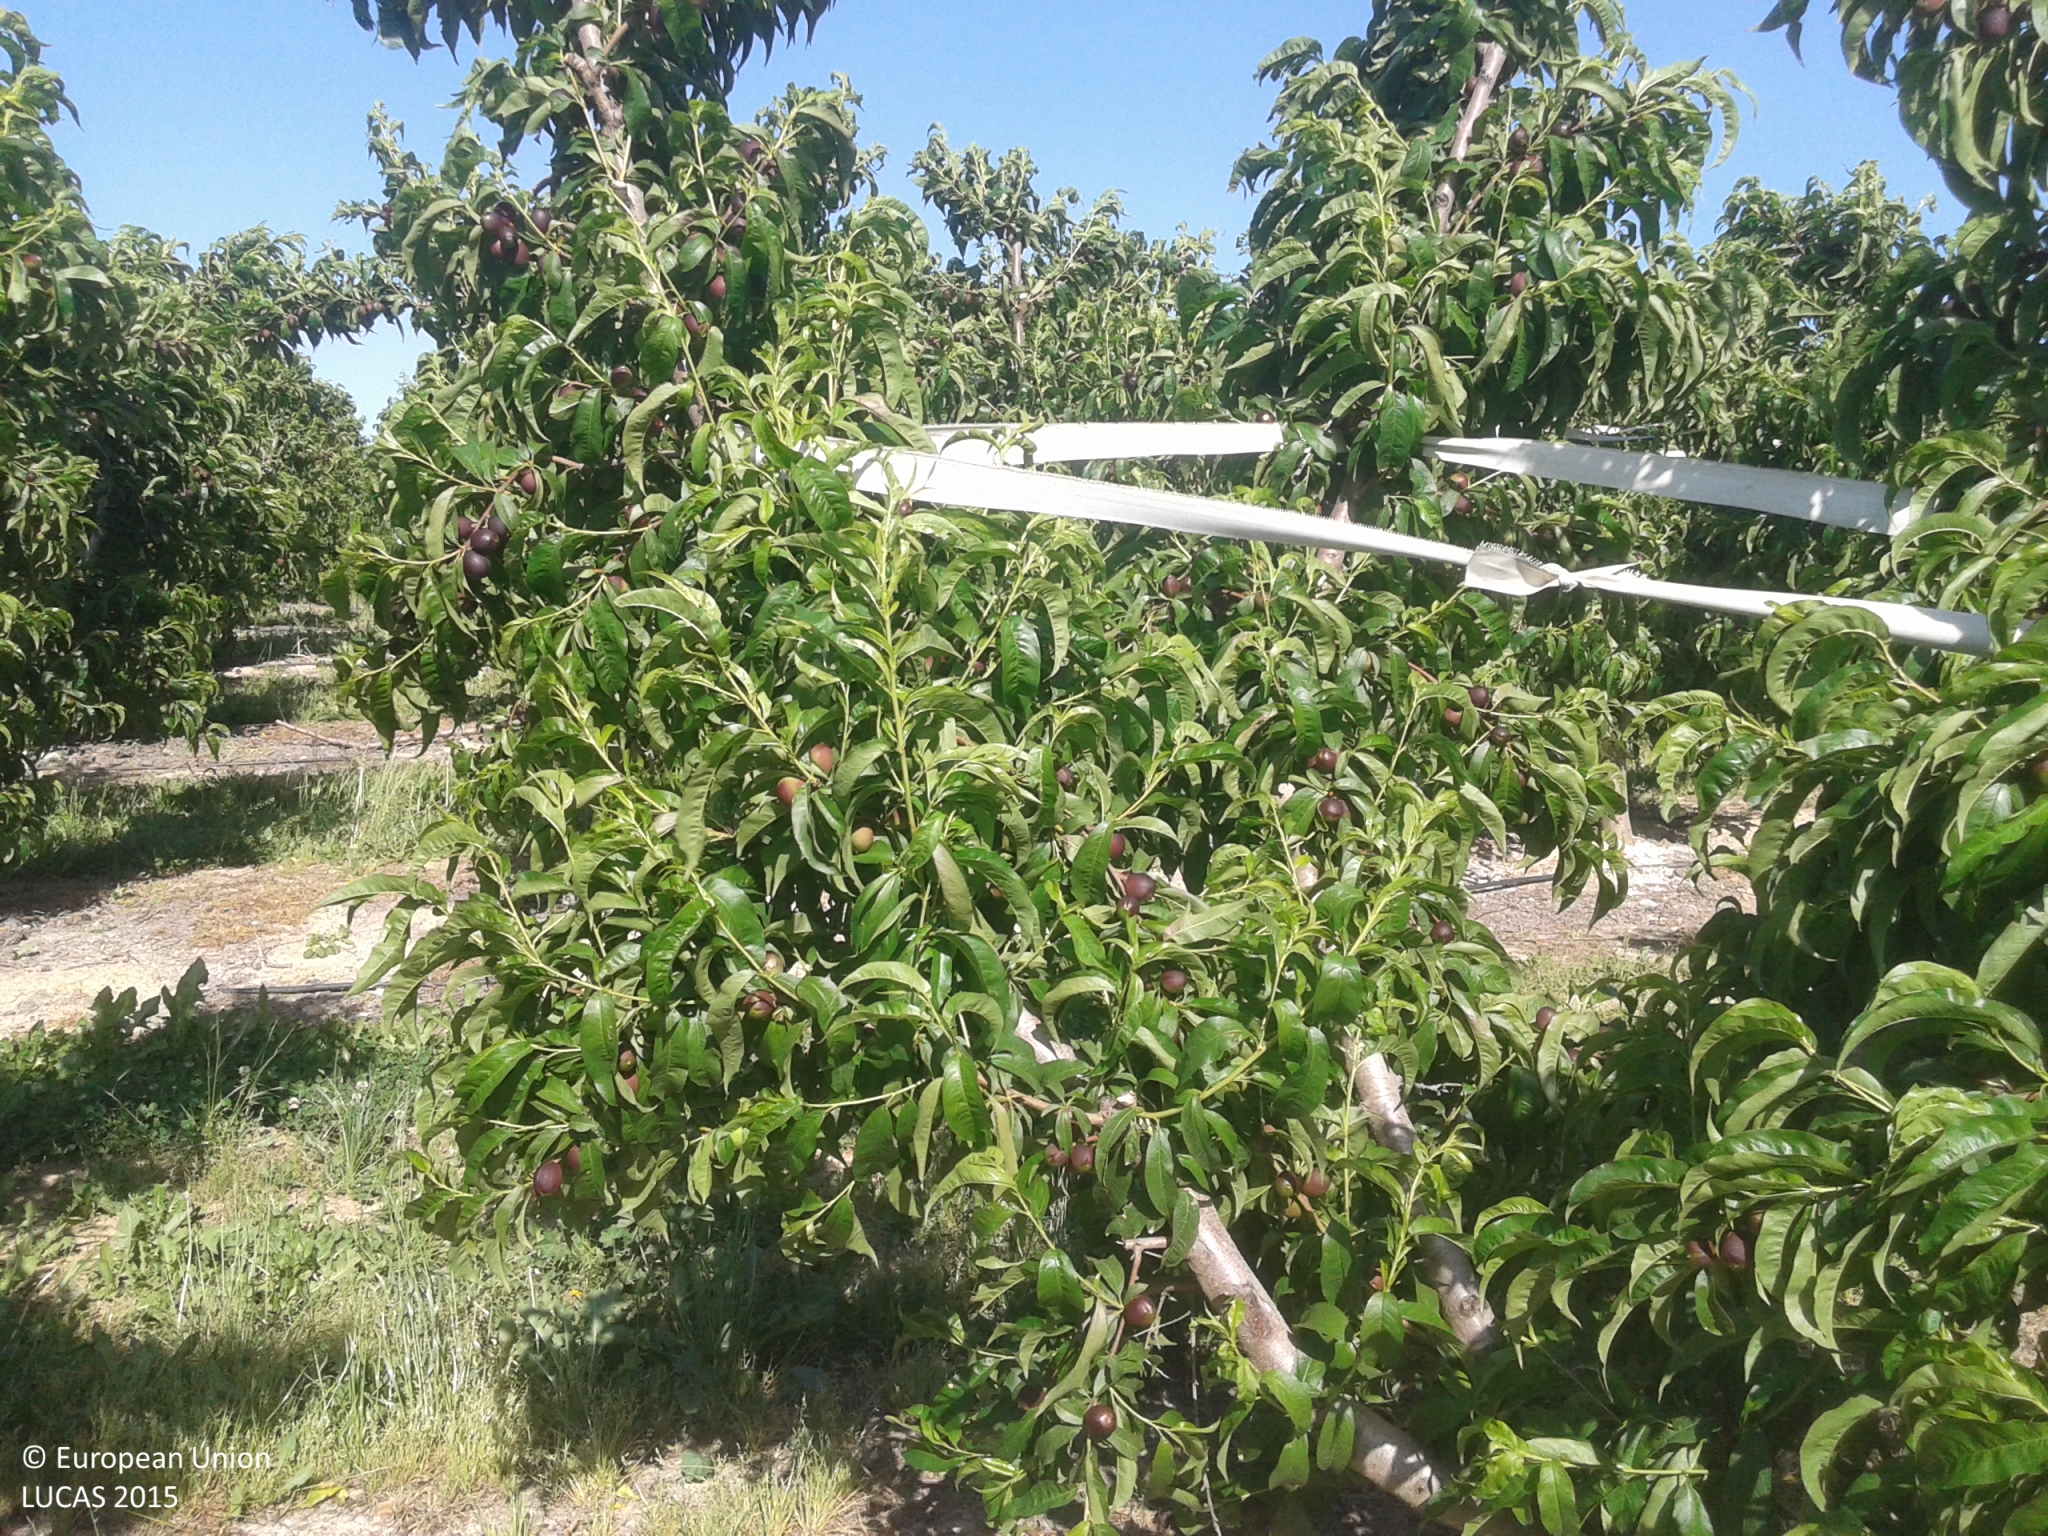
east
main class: Cropland
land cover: Other fruit trees and berries
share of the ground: 25 - 50 %
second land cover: Spontaneously vegetated surfaces
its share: 50 - 75 %
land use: Agriculture (excluding fallow land and kitchen gardens)
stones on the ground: < 10 %
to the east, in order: Other fruit trees and berries; Spontaneously vegetated surfaces; Tracks; Grass margins; Tracks; Other fruit trees and berries
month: May
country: ES
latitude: 41.7856
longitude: 0.6614
